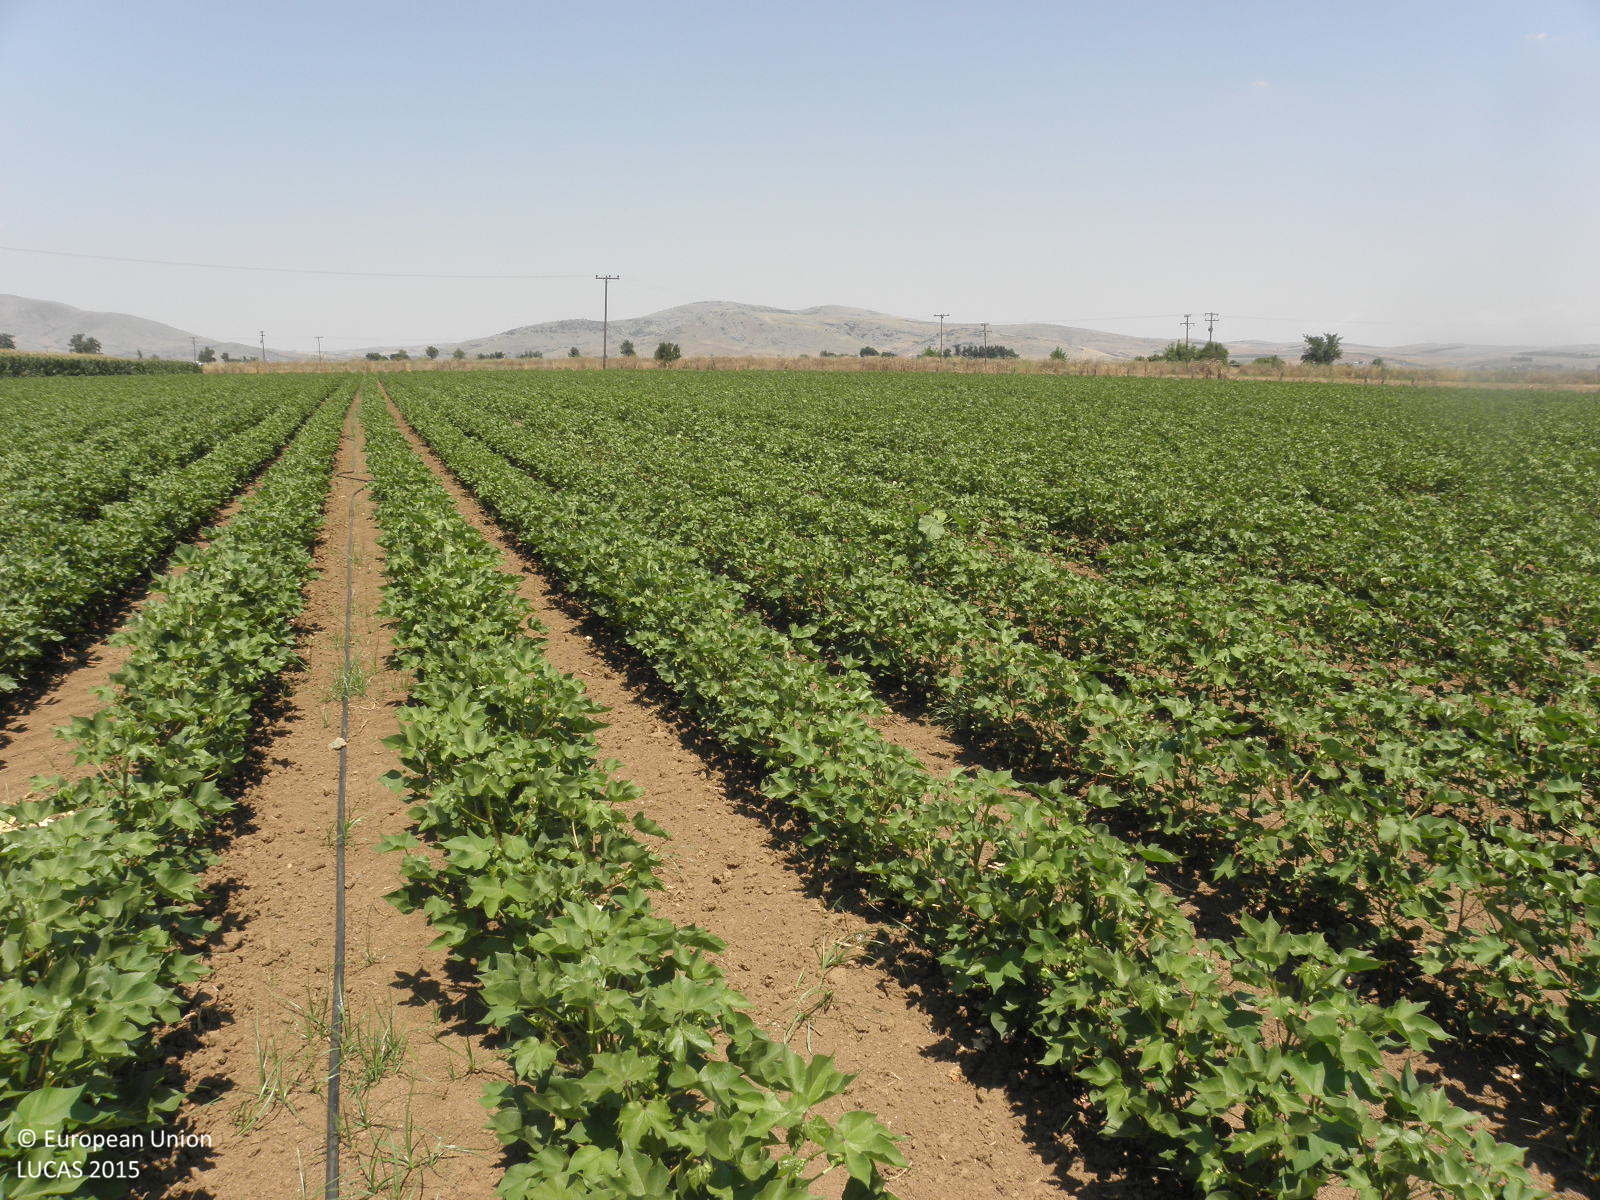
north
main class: Cropland
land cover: Cotton
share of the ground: > 75 %
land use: Agriculture (excluding fallow land and kitchen gardens)
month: July
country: GR
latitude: 39.3623
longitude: 22.2994
